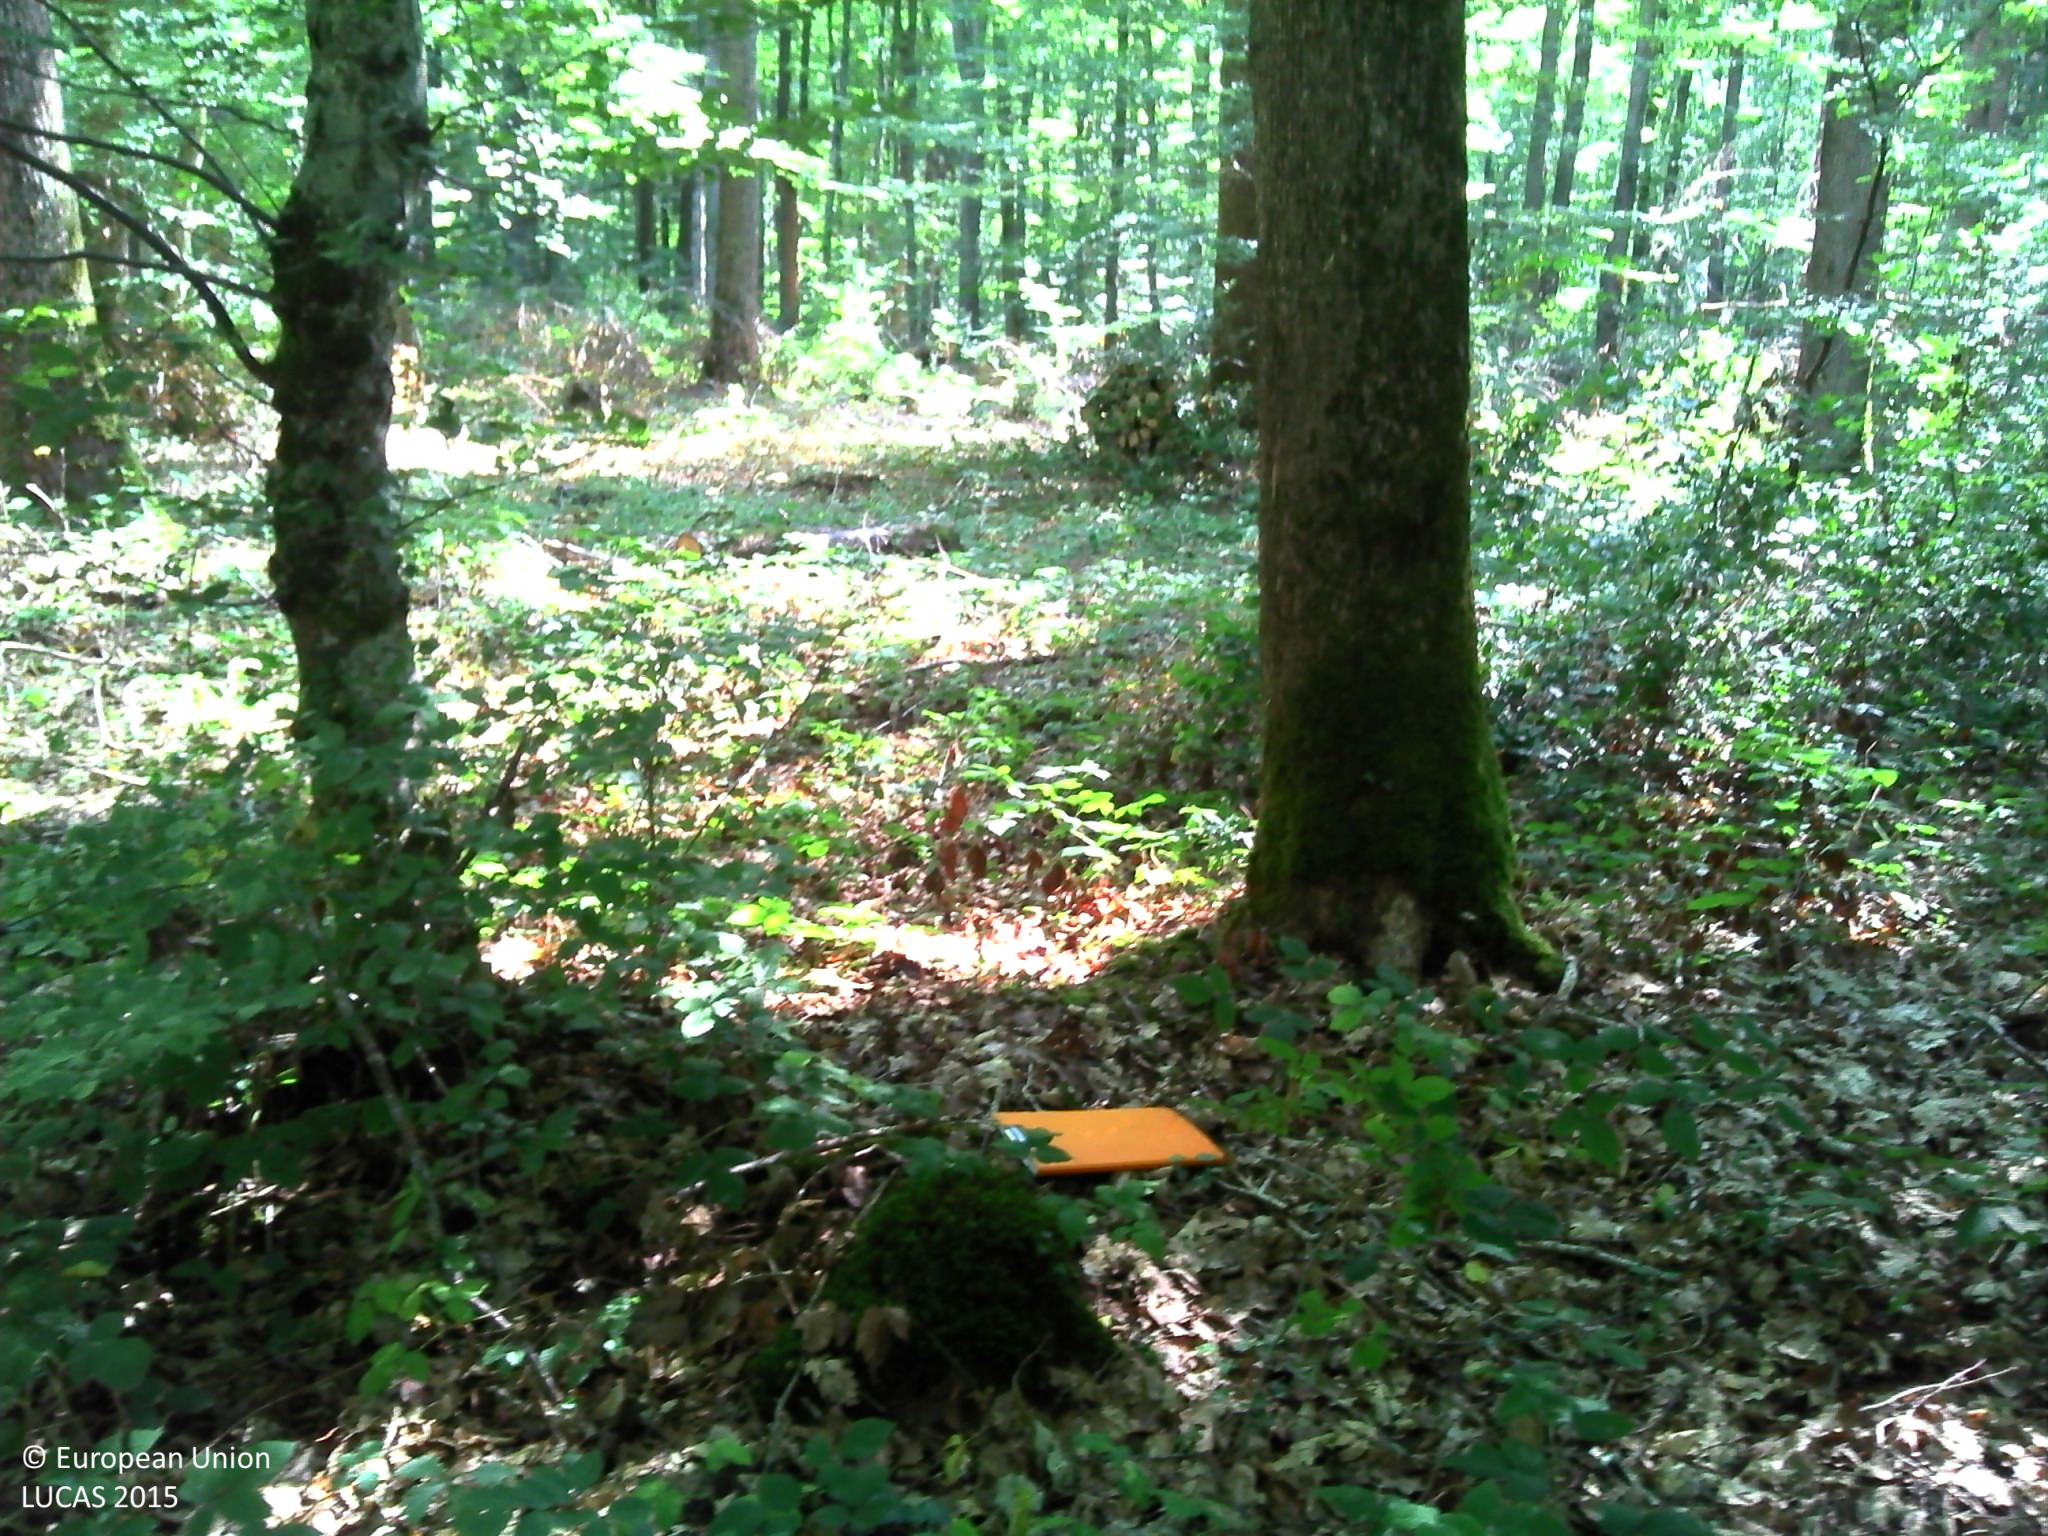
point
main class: Woodland
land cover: Broadleaved woodland
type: mesophytic deciduous forest
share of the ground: > 75 %
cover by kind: broadleaved forest trees 95 %, herbaceous plants 5 %
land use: Forestry
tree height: > 5 m
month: August
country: FR
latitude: 46.6309
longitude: 2.7728
